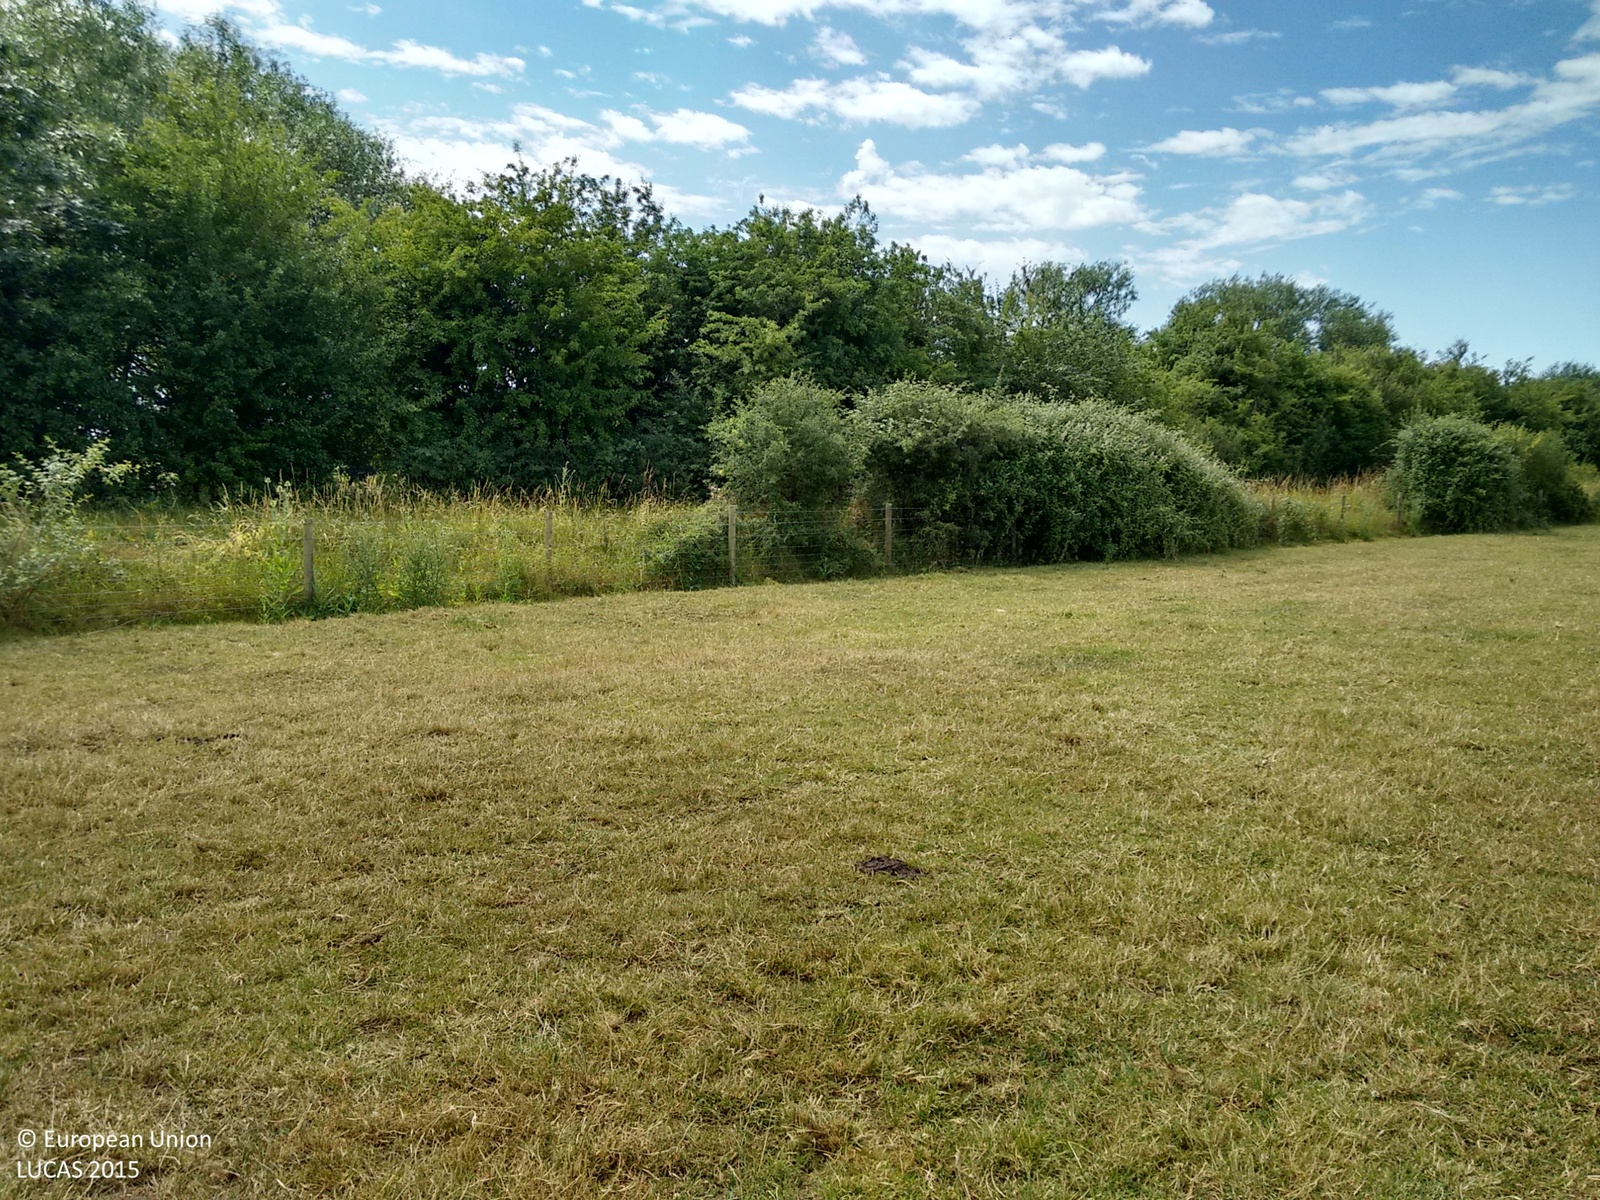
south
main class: Grassland
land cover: Grassland without tree/shrub cover
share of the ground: > 75 %
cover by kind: herbaceous plants 100 %
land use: Agriculture (excluding fallow land and kitchen gardens)
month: July
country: GB
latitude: 51.6441
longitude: -1.2181
